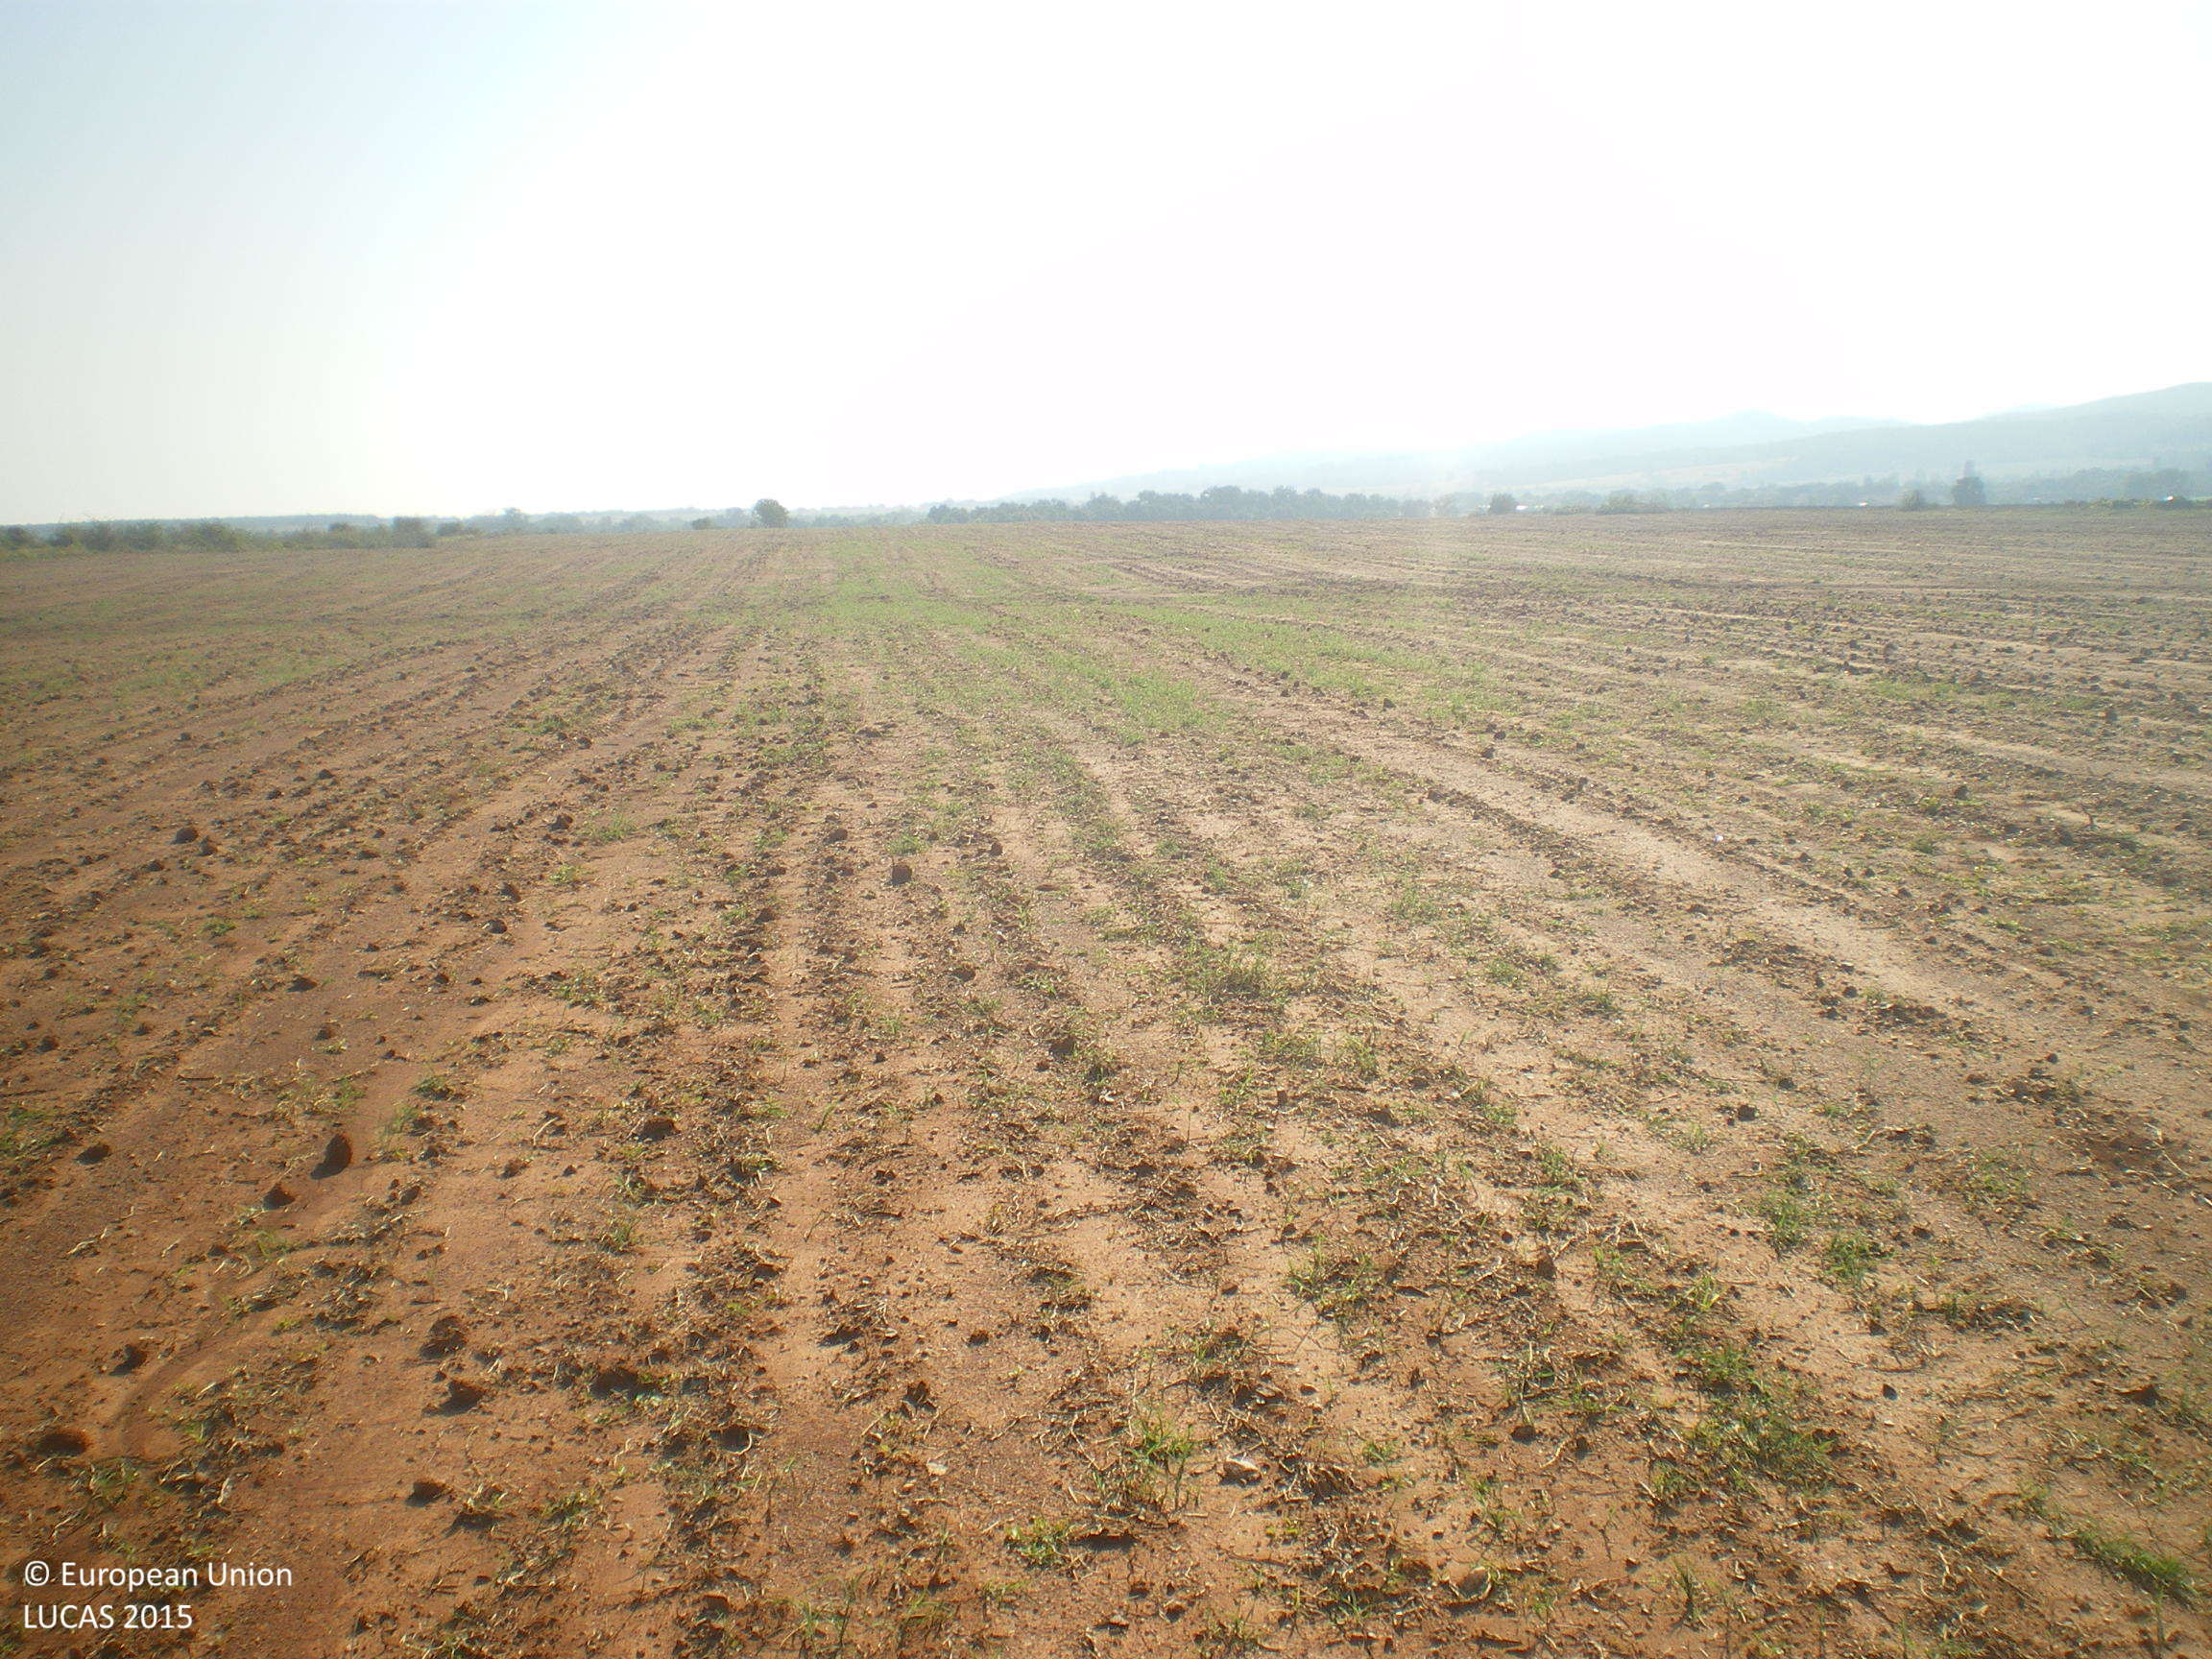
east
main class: Cropland
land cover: Common wheat
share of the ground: < 10 %
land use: Agriculture (excluding fallow land and kitchen gardens)
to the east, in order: Common wheat; Shrubland without tree cover; Tracks; Grassland with sparse tree/shrub cover
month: September
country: BG
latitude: 41.7762
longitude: 25.8895
